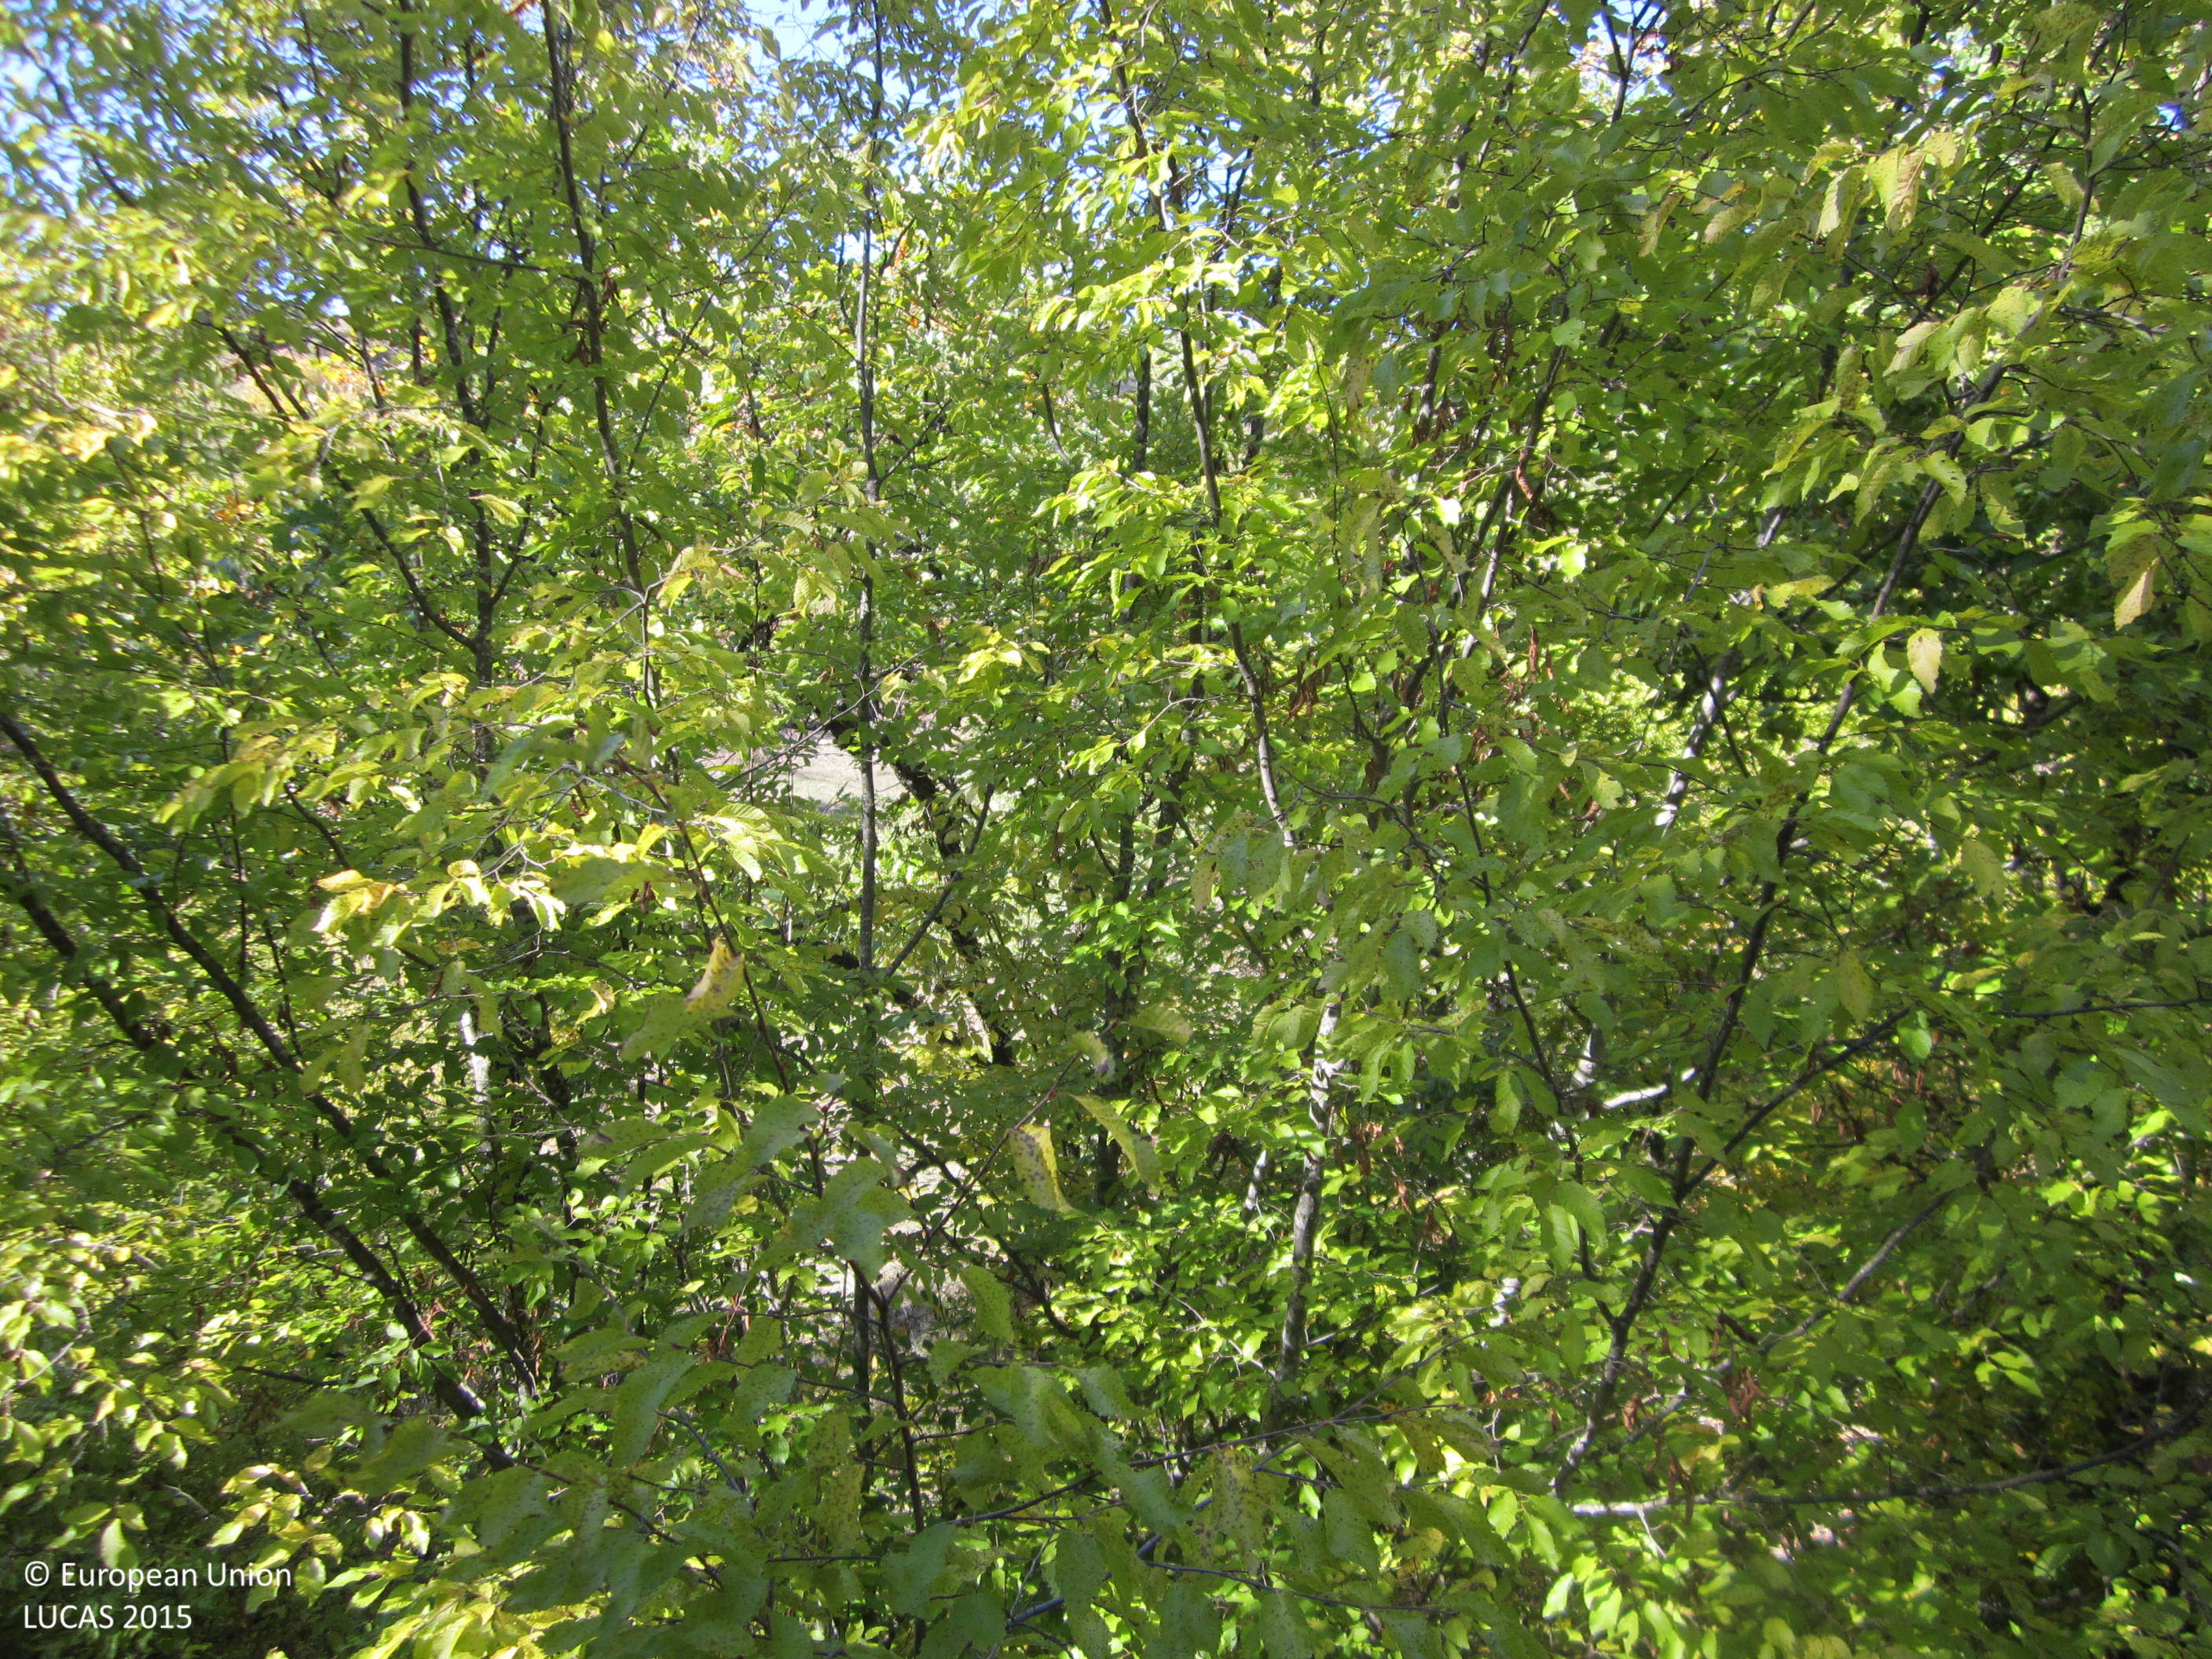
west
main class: Woodland
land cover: Broadleaved woodland
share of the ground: > 75 %
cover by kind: broadleaved forest trees 80 %, herbaceous plants 15 %, shrubs 5 %
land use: Forestry
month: November
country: BG
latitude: 41.4589
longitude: 25.8062
